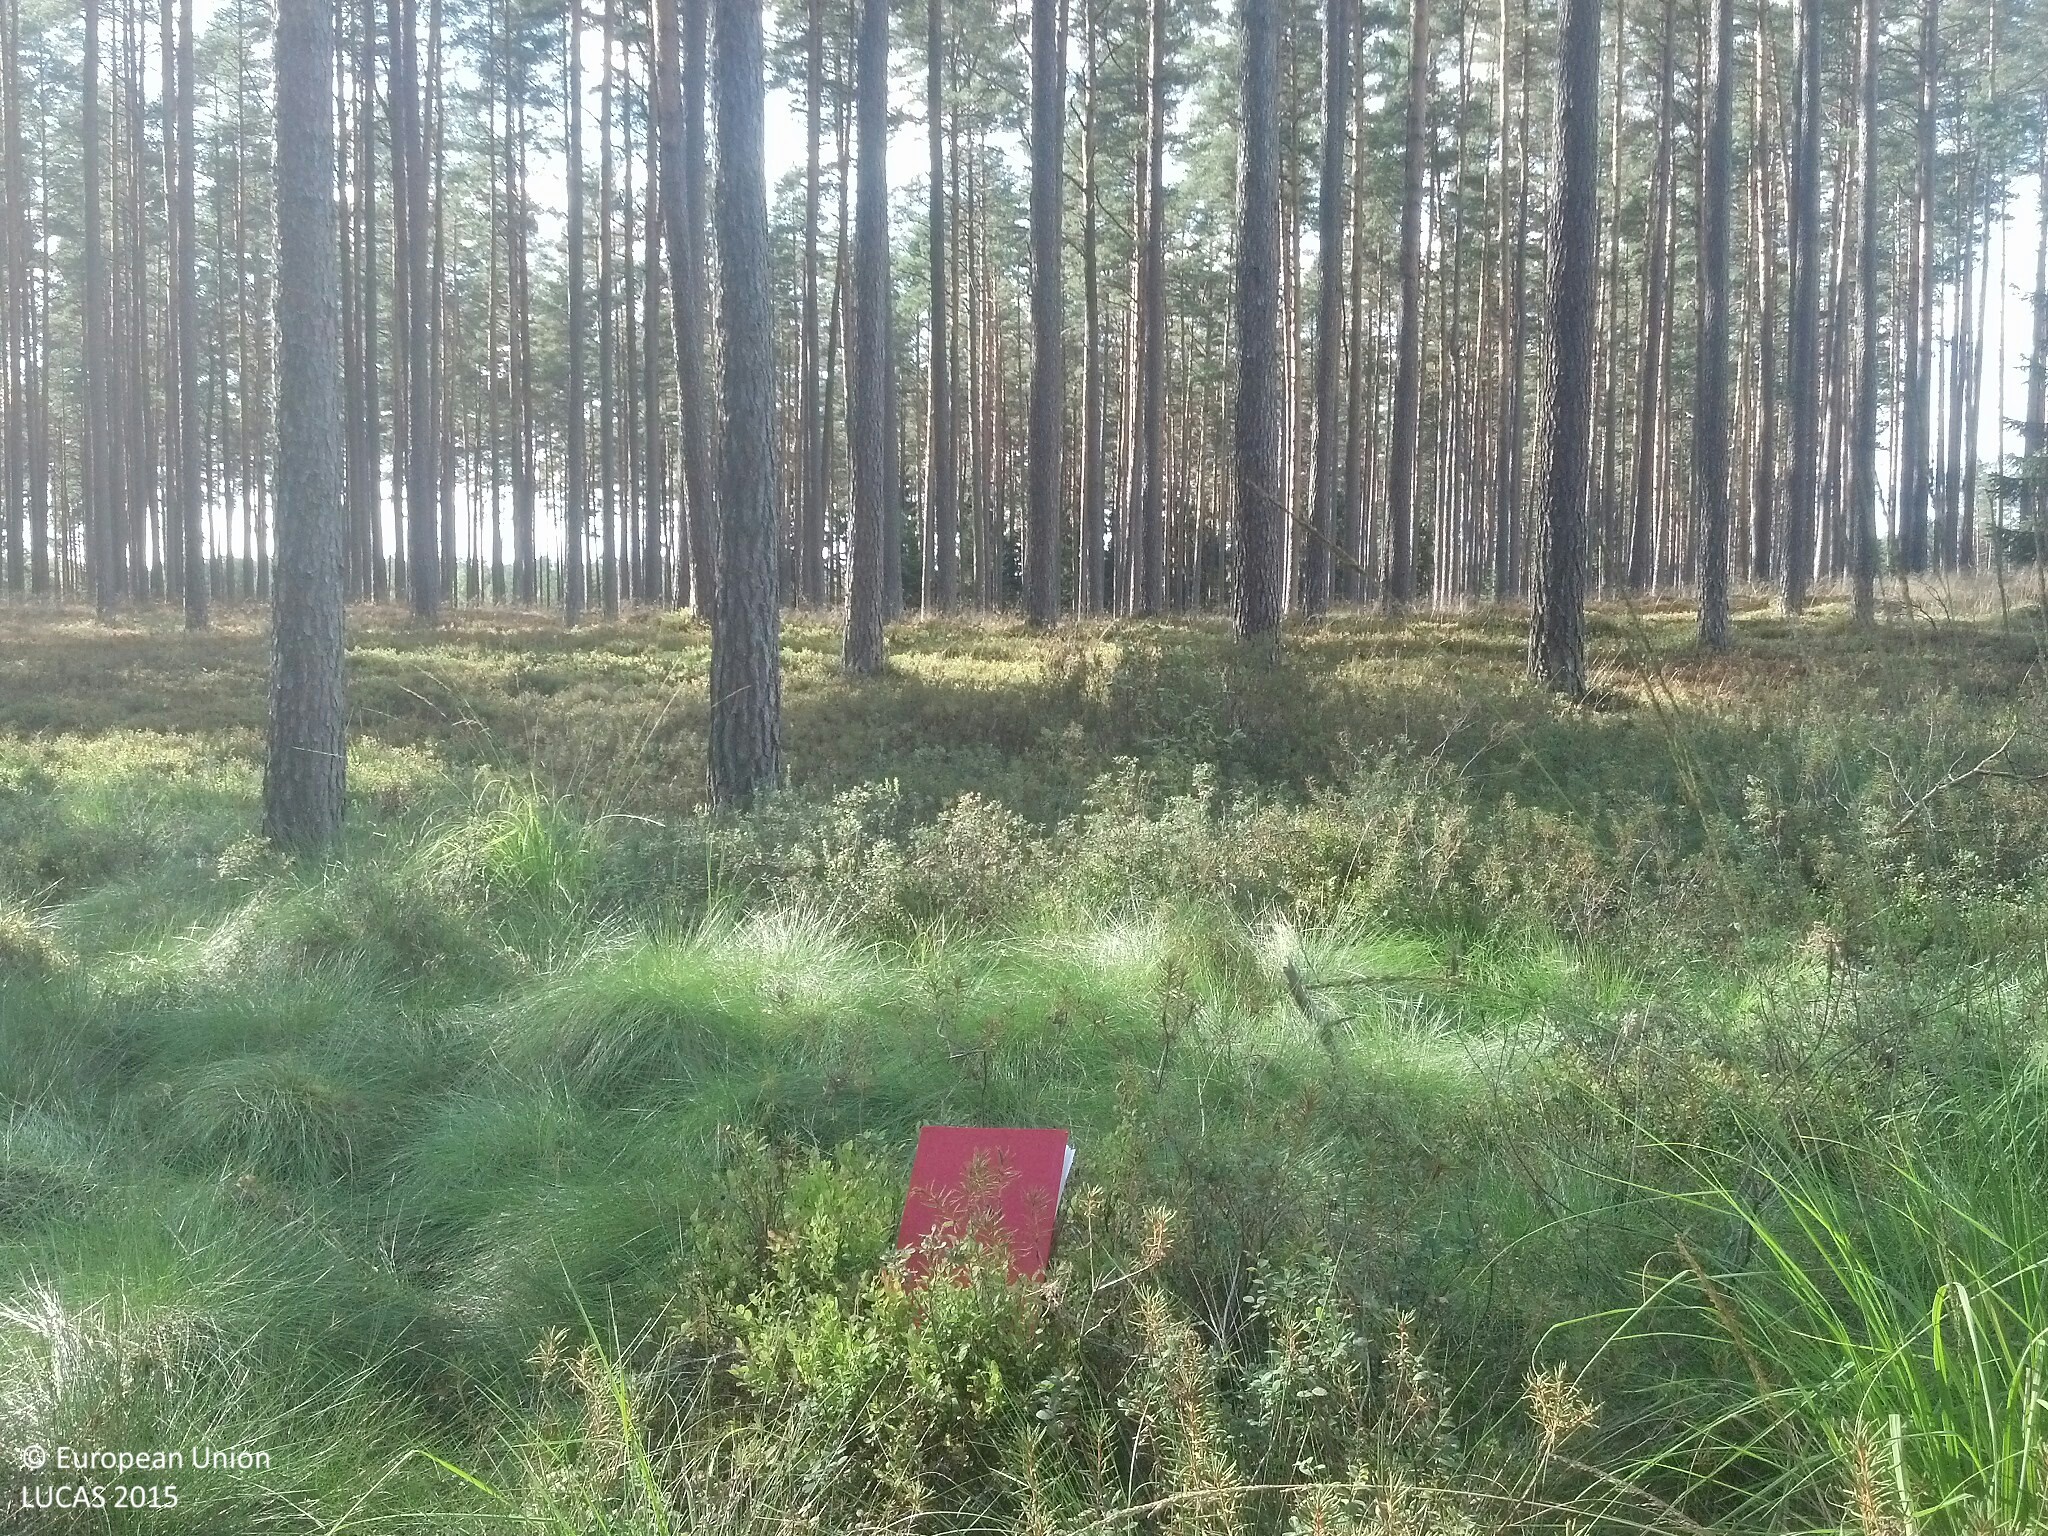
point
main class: Woodland
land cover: Pine dominated coniferous woodland
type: hemiboreal forest and nemoral coniferous forest and mixed broadleaved-coniferous forest
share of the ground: > 75 %
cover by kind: coniferous forest trees 85 %, herbaceous plants 10 %, shrubs 5 %
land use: Forestry
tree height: > 5 m
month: August
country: PL
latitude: 53.9286
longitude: 17.1827
